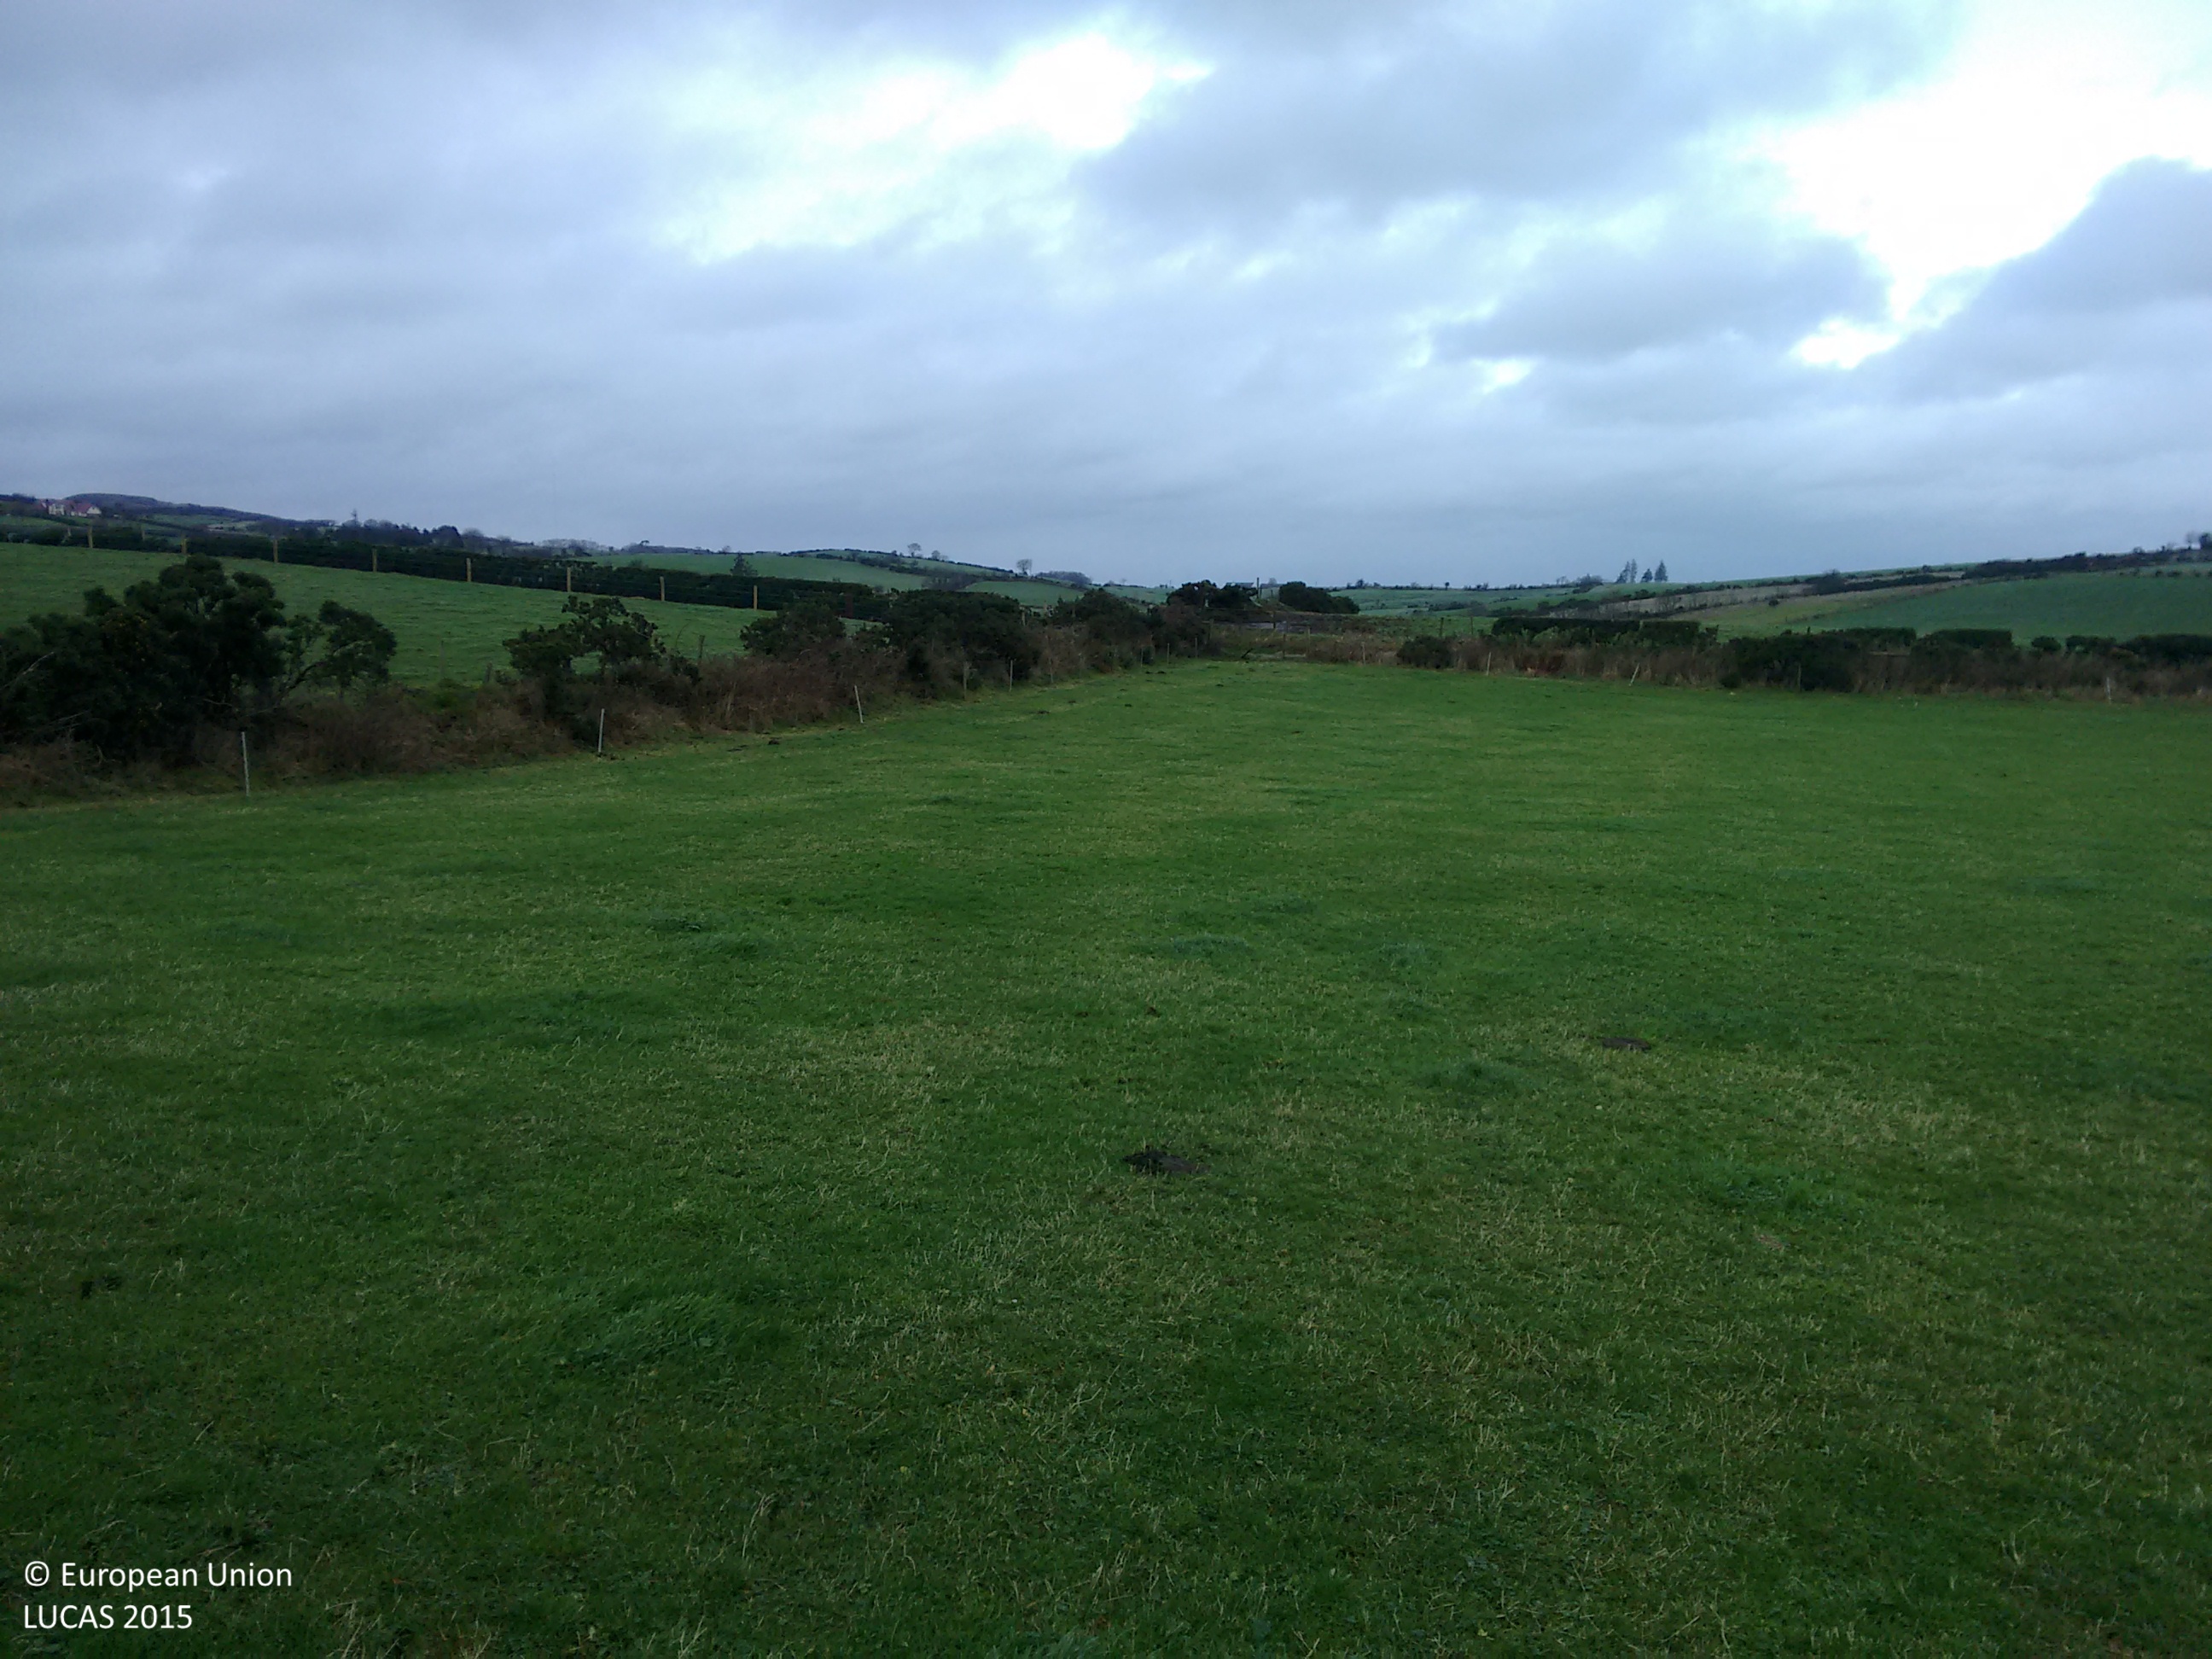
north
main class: Grassland
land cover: Grassland without tree/shrub cover
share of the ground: > 75 %
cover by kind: herbaceous plants 100 %
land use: Agriculture (excluding fallow land and kitchen gardens)
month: December
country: IE
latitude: 53.9342
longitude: -6.8767
